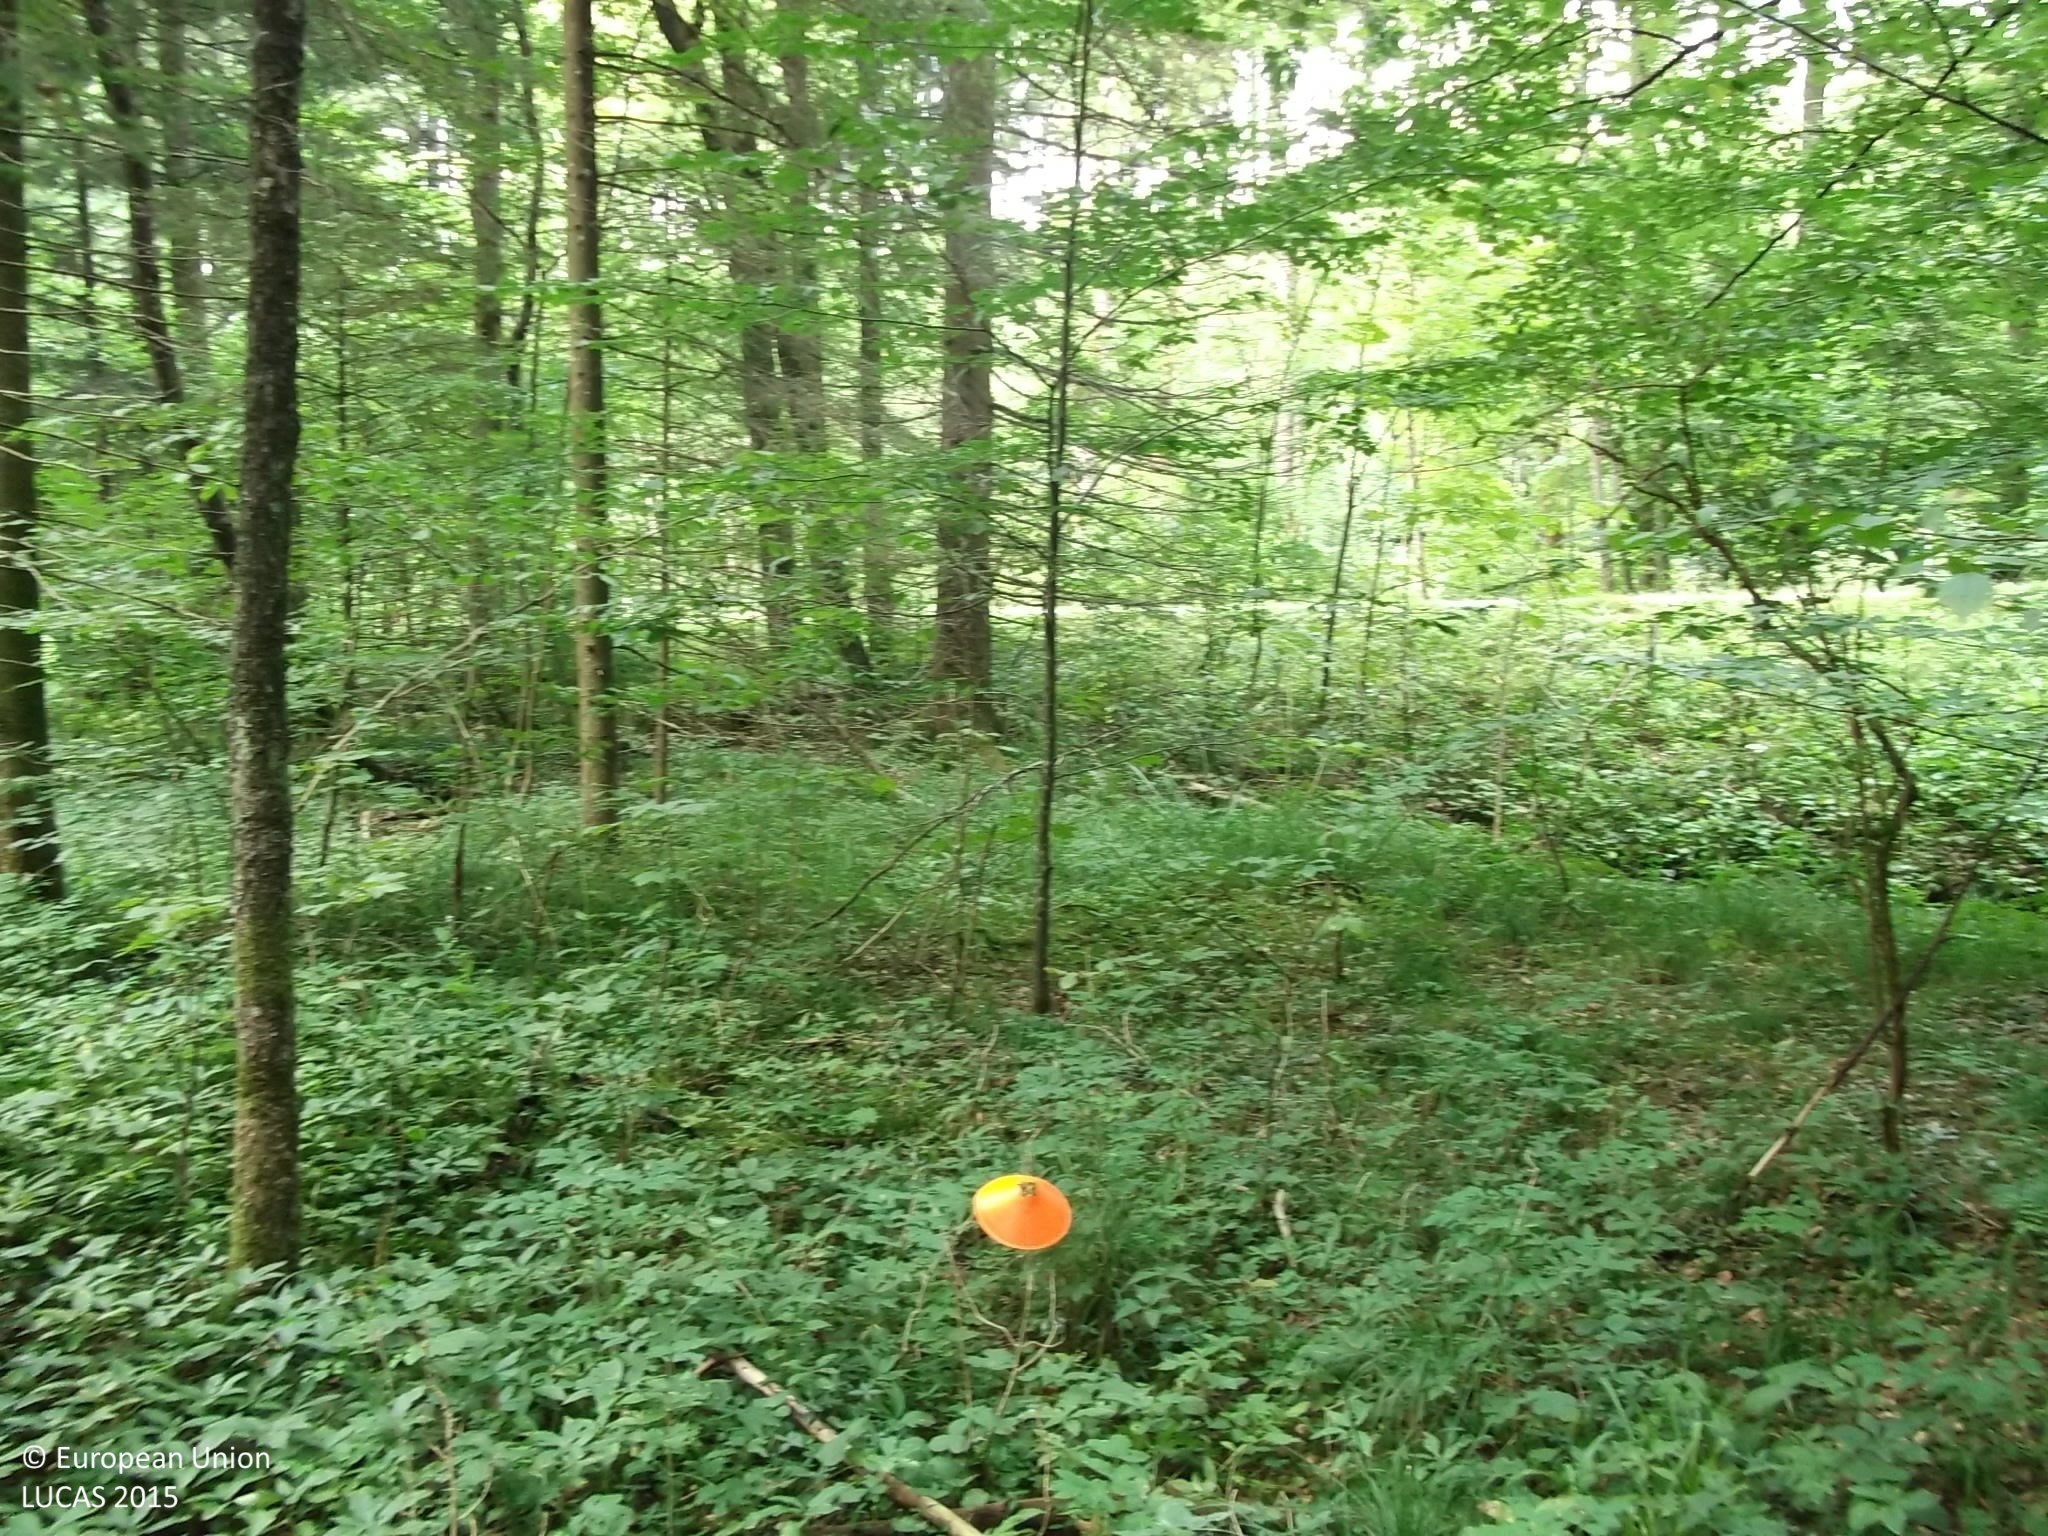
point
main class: Woodland
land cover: Spruce dominated mixed woodland
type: hemiboreal forest and nemoral coniferous forest and mixed broadleaved-coniferous forest
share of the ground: > 75 %
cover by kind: coniferous forest trees 45 %, broadleaved forest trees 40 %, herbaceous plants 15 %
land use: Forestry
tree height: > 5 m
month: August
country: AT
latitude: 47.9383
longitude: 13.3589
